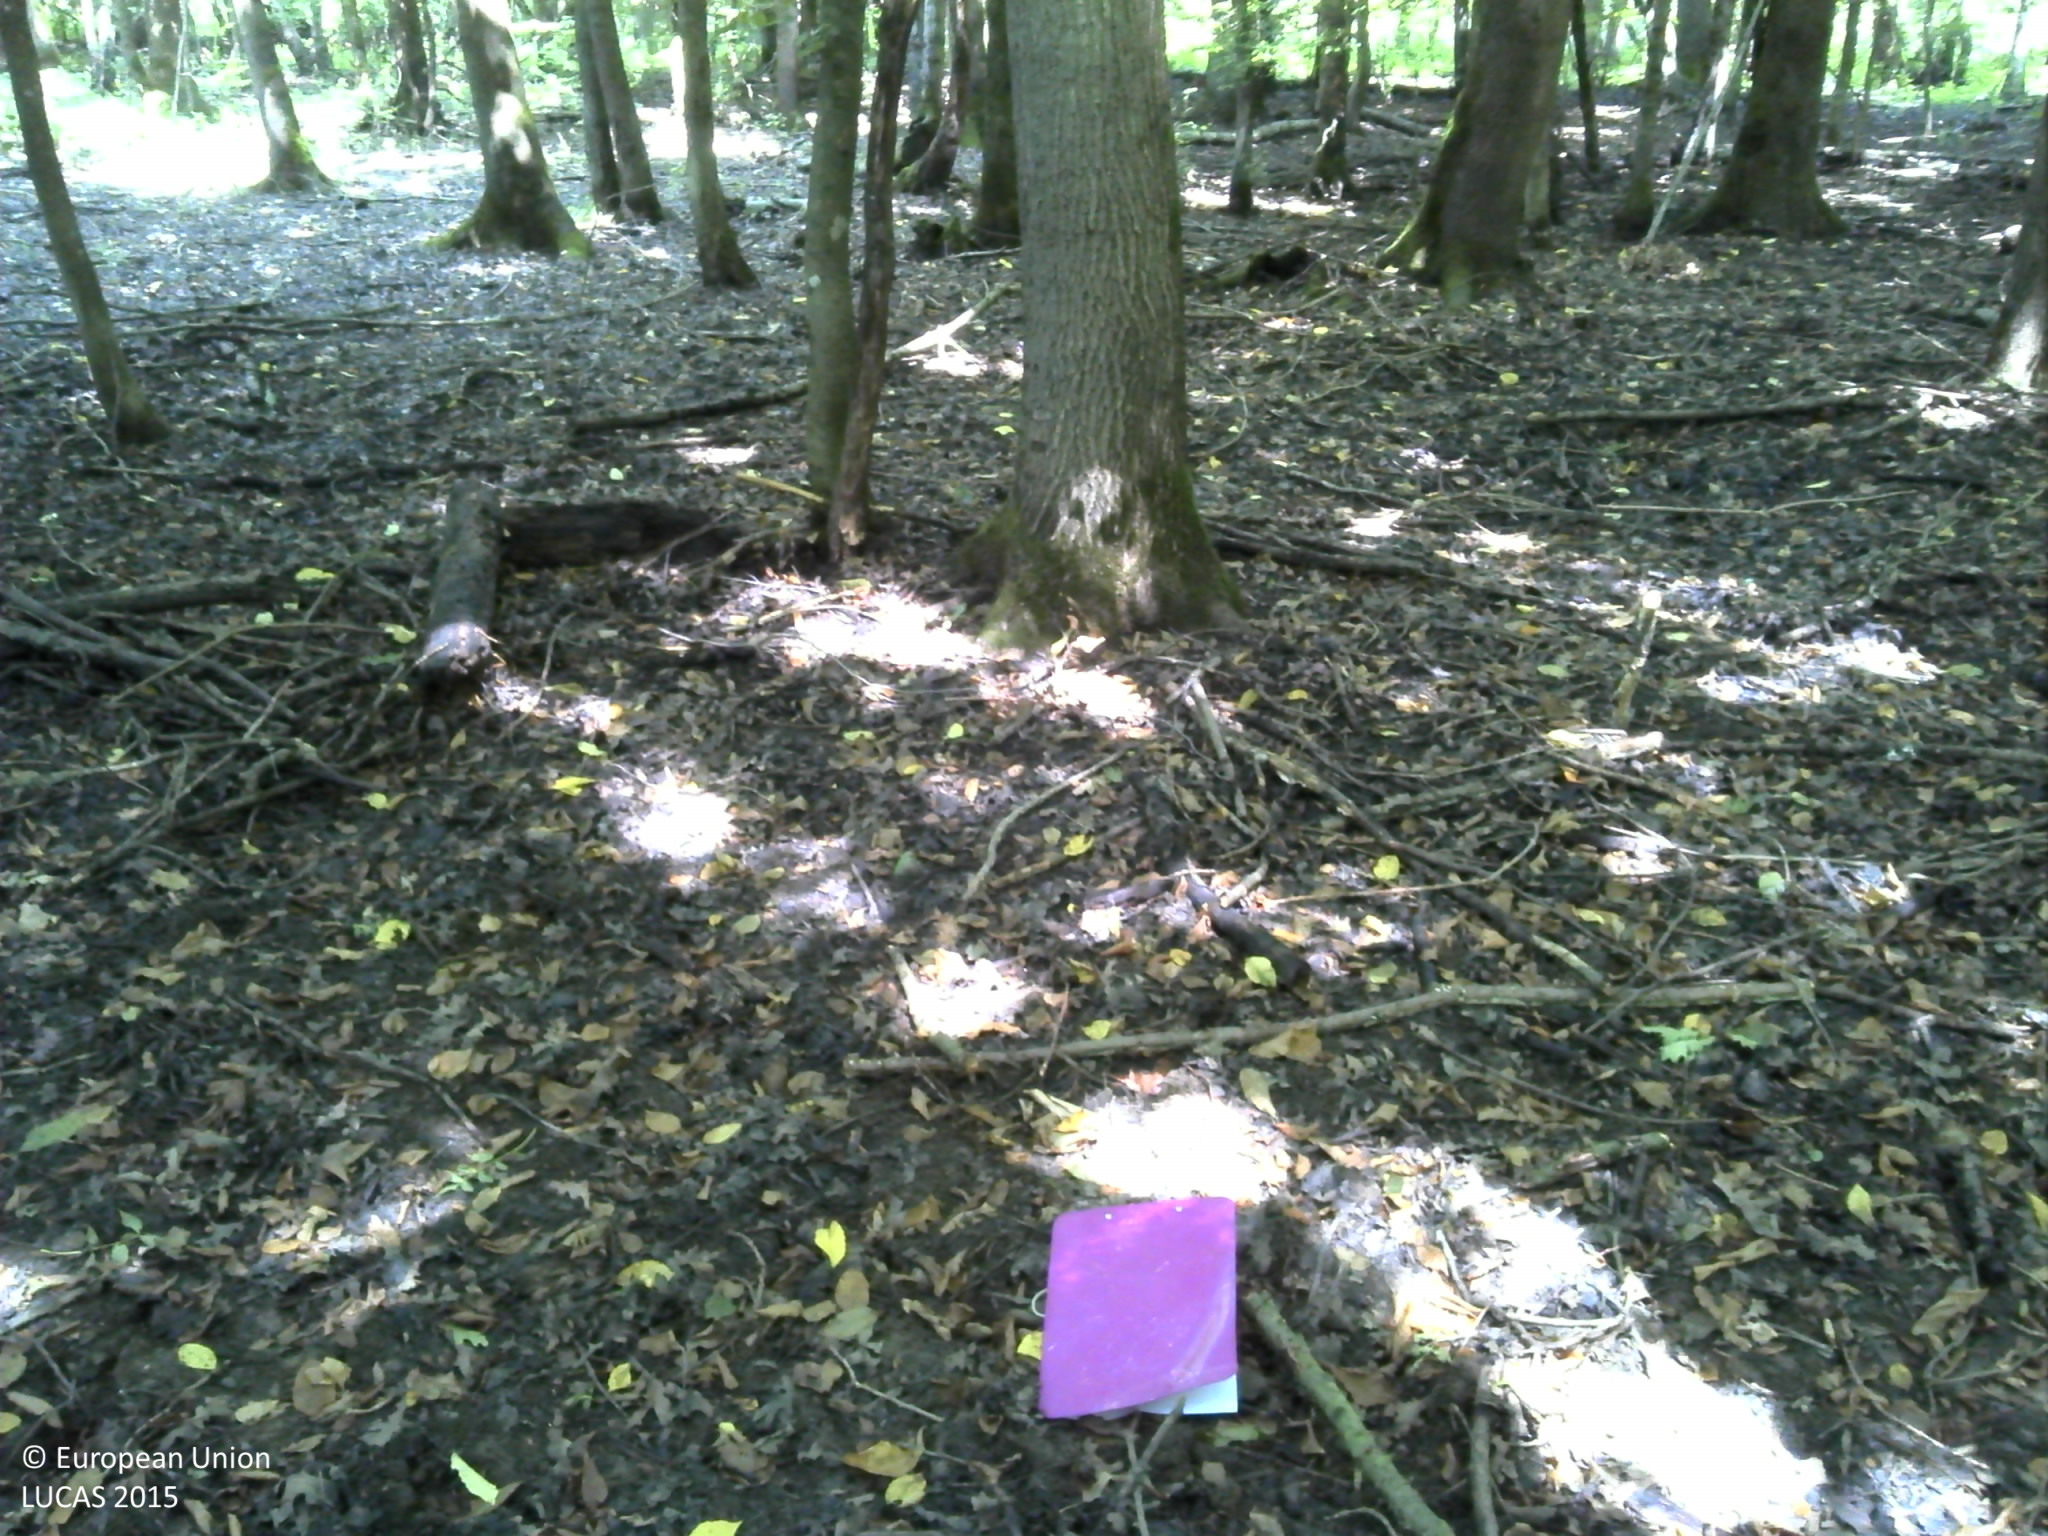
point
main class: Woodland
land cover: Broadleaved woodland
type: acidophilous oak and oak-birch forest
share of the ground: > 75 %
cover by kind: broadleaved forest trees 100 %
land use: Forestry
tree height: > 5 m
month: August
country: HR
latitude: 45.5185
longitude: 16.5401
